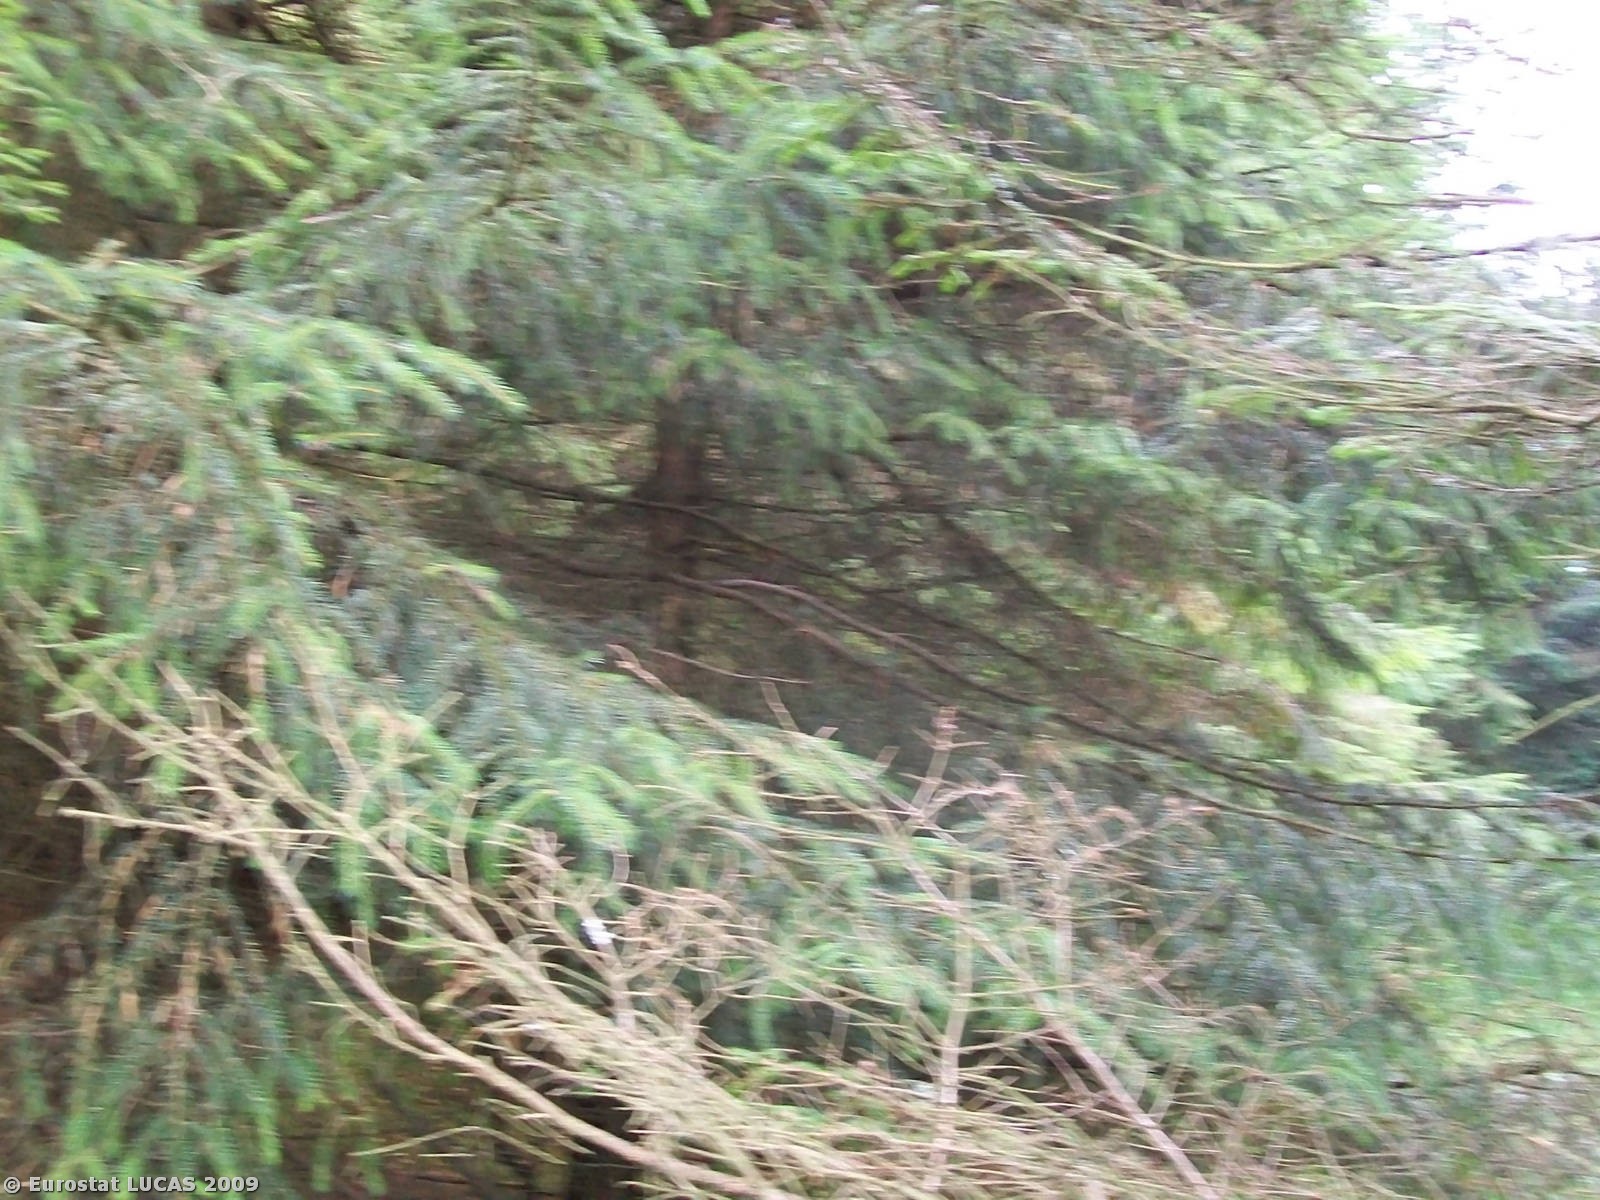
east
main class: Woodland
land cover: Coniferous woodland
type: plantations and self-sown exotic forest
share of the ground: > 75 %
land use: Forestry
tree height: > 5 m
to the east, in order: Coniferous woodland
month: September
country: GB
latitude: 55.5830
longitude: -4.2936
